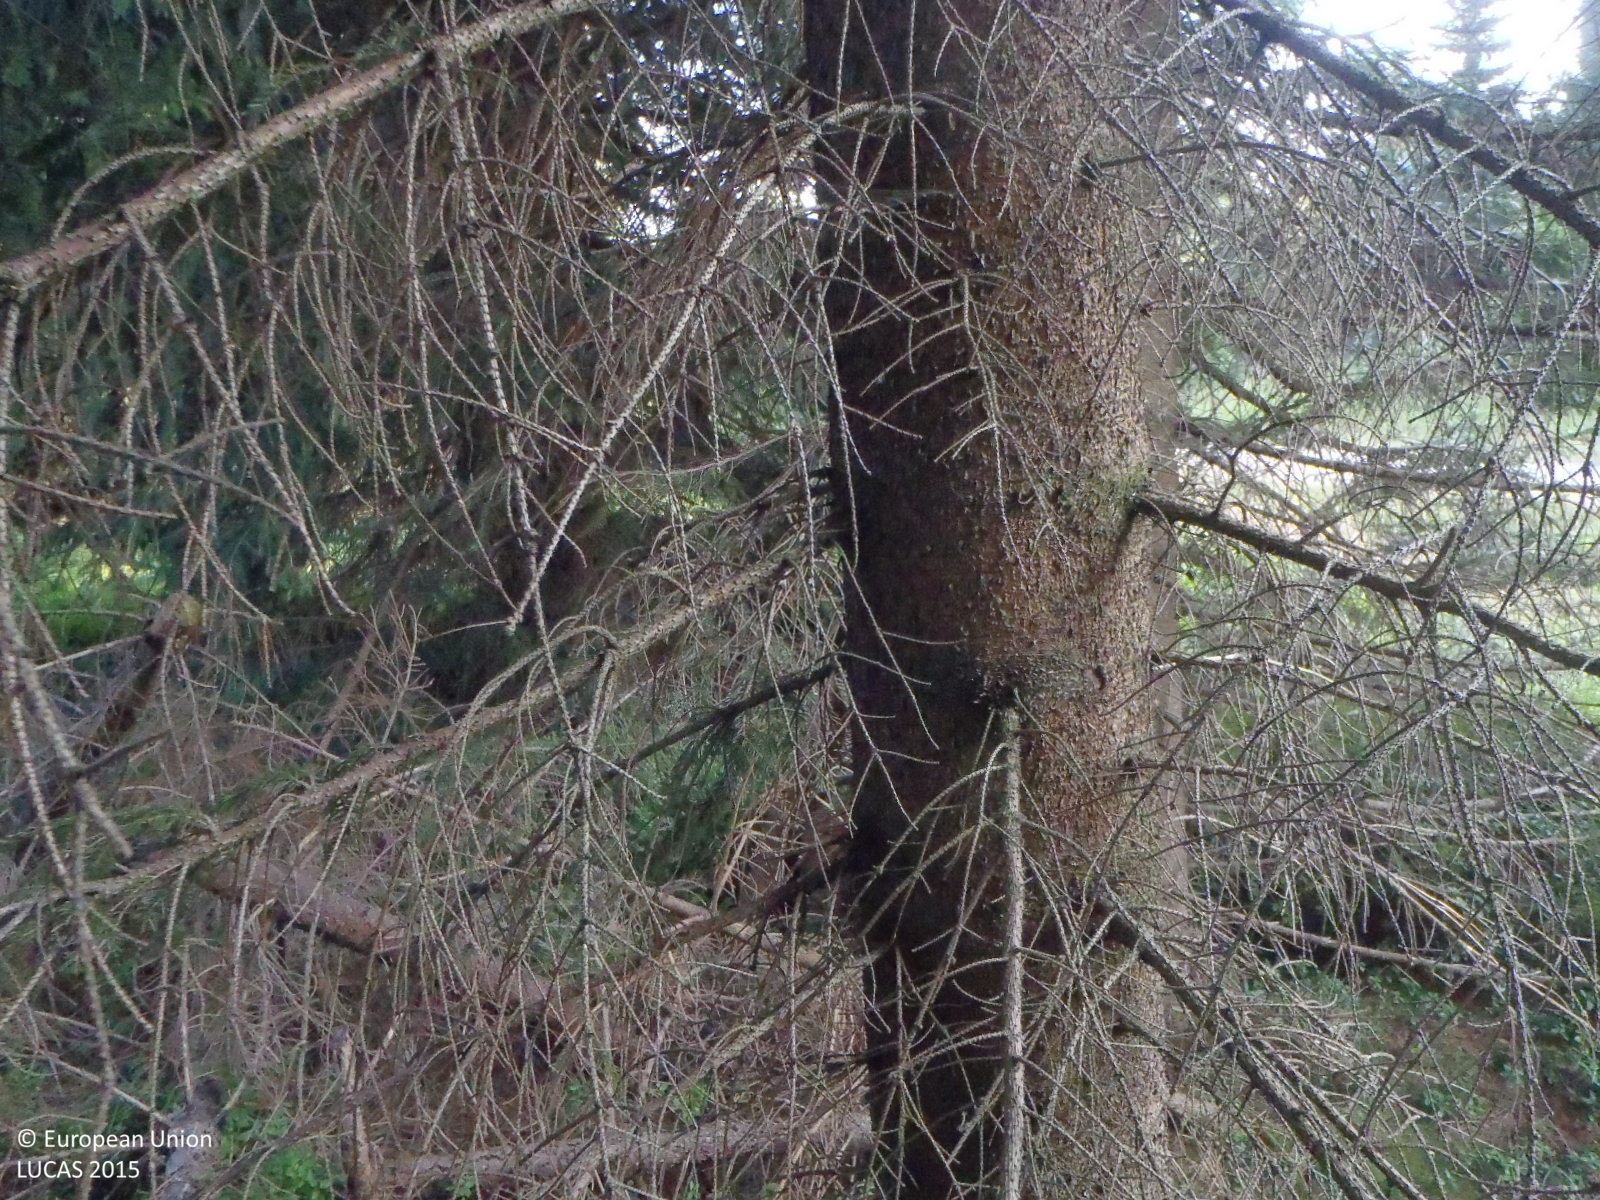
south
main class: Woodland
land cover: Spruce dominated coniferous woodland
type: hemiboreal forest and nemoral coniferous forest and mixed broadleaved-coniferous forest
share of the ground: > 75 %
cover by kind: coniferous forest trees 80 %, shrubs 10 %, herbaceous plants 10 %
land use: Forestry
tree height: > 5 m
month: August
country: CZ
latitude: 50.8551
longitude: 15.2738
